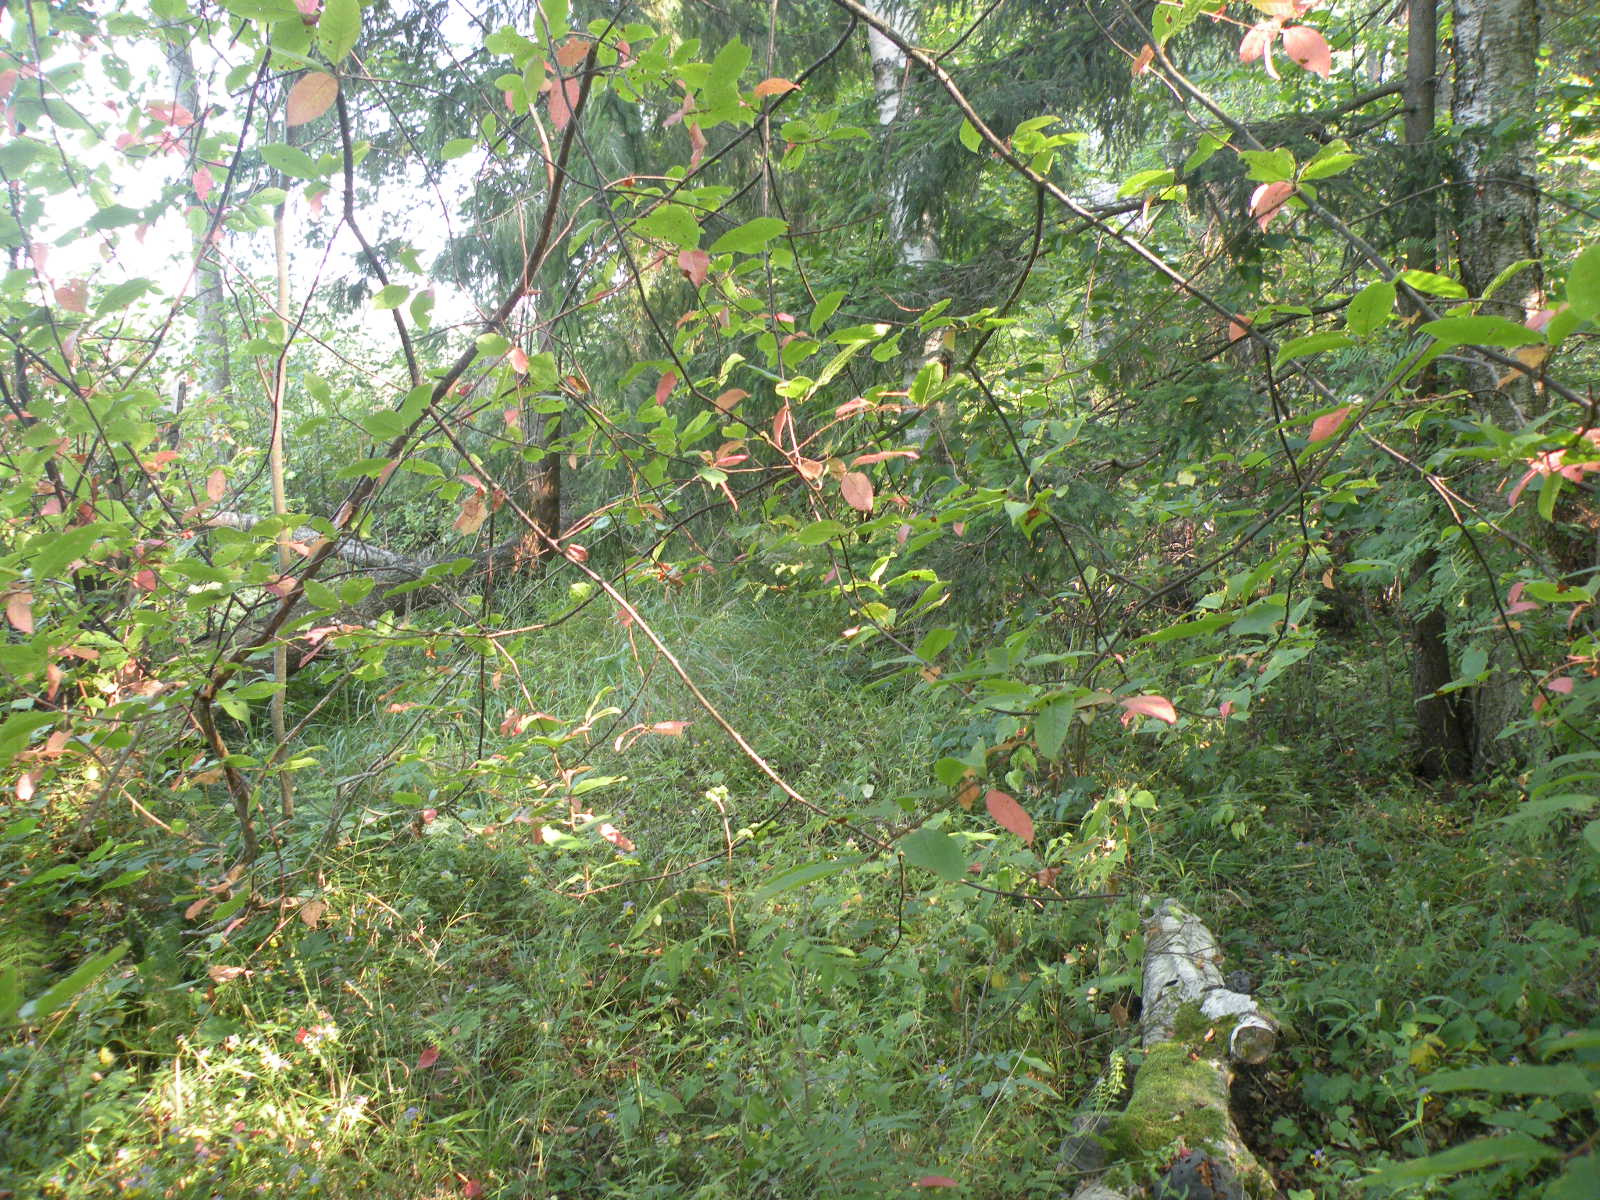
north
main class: Woodland
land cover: Spruce dominated mixed woodland
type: hemiboreal forest and nemoral coniferous forest and mixed broadleaved-coniferous forest
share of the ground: > 75 %
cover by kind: coniferous forest trees 60 %, broadleaved forest trees 25 %, herbaceous plants 10 %, shrubs 5 %
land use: Forestry
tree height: > 5 m
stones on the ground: < 10 %
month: August
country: LV
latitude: 55.7730
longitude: 26.6221
